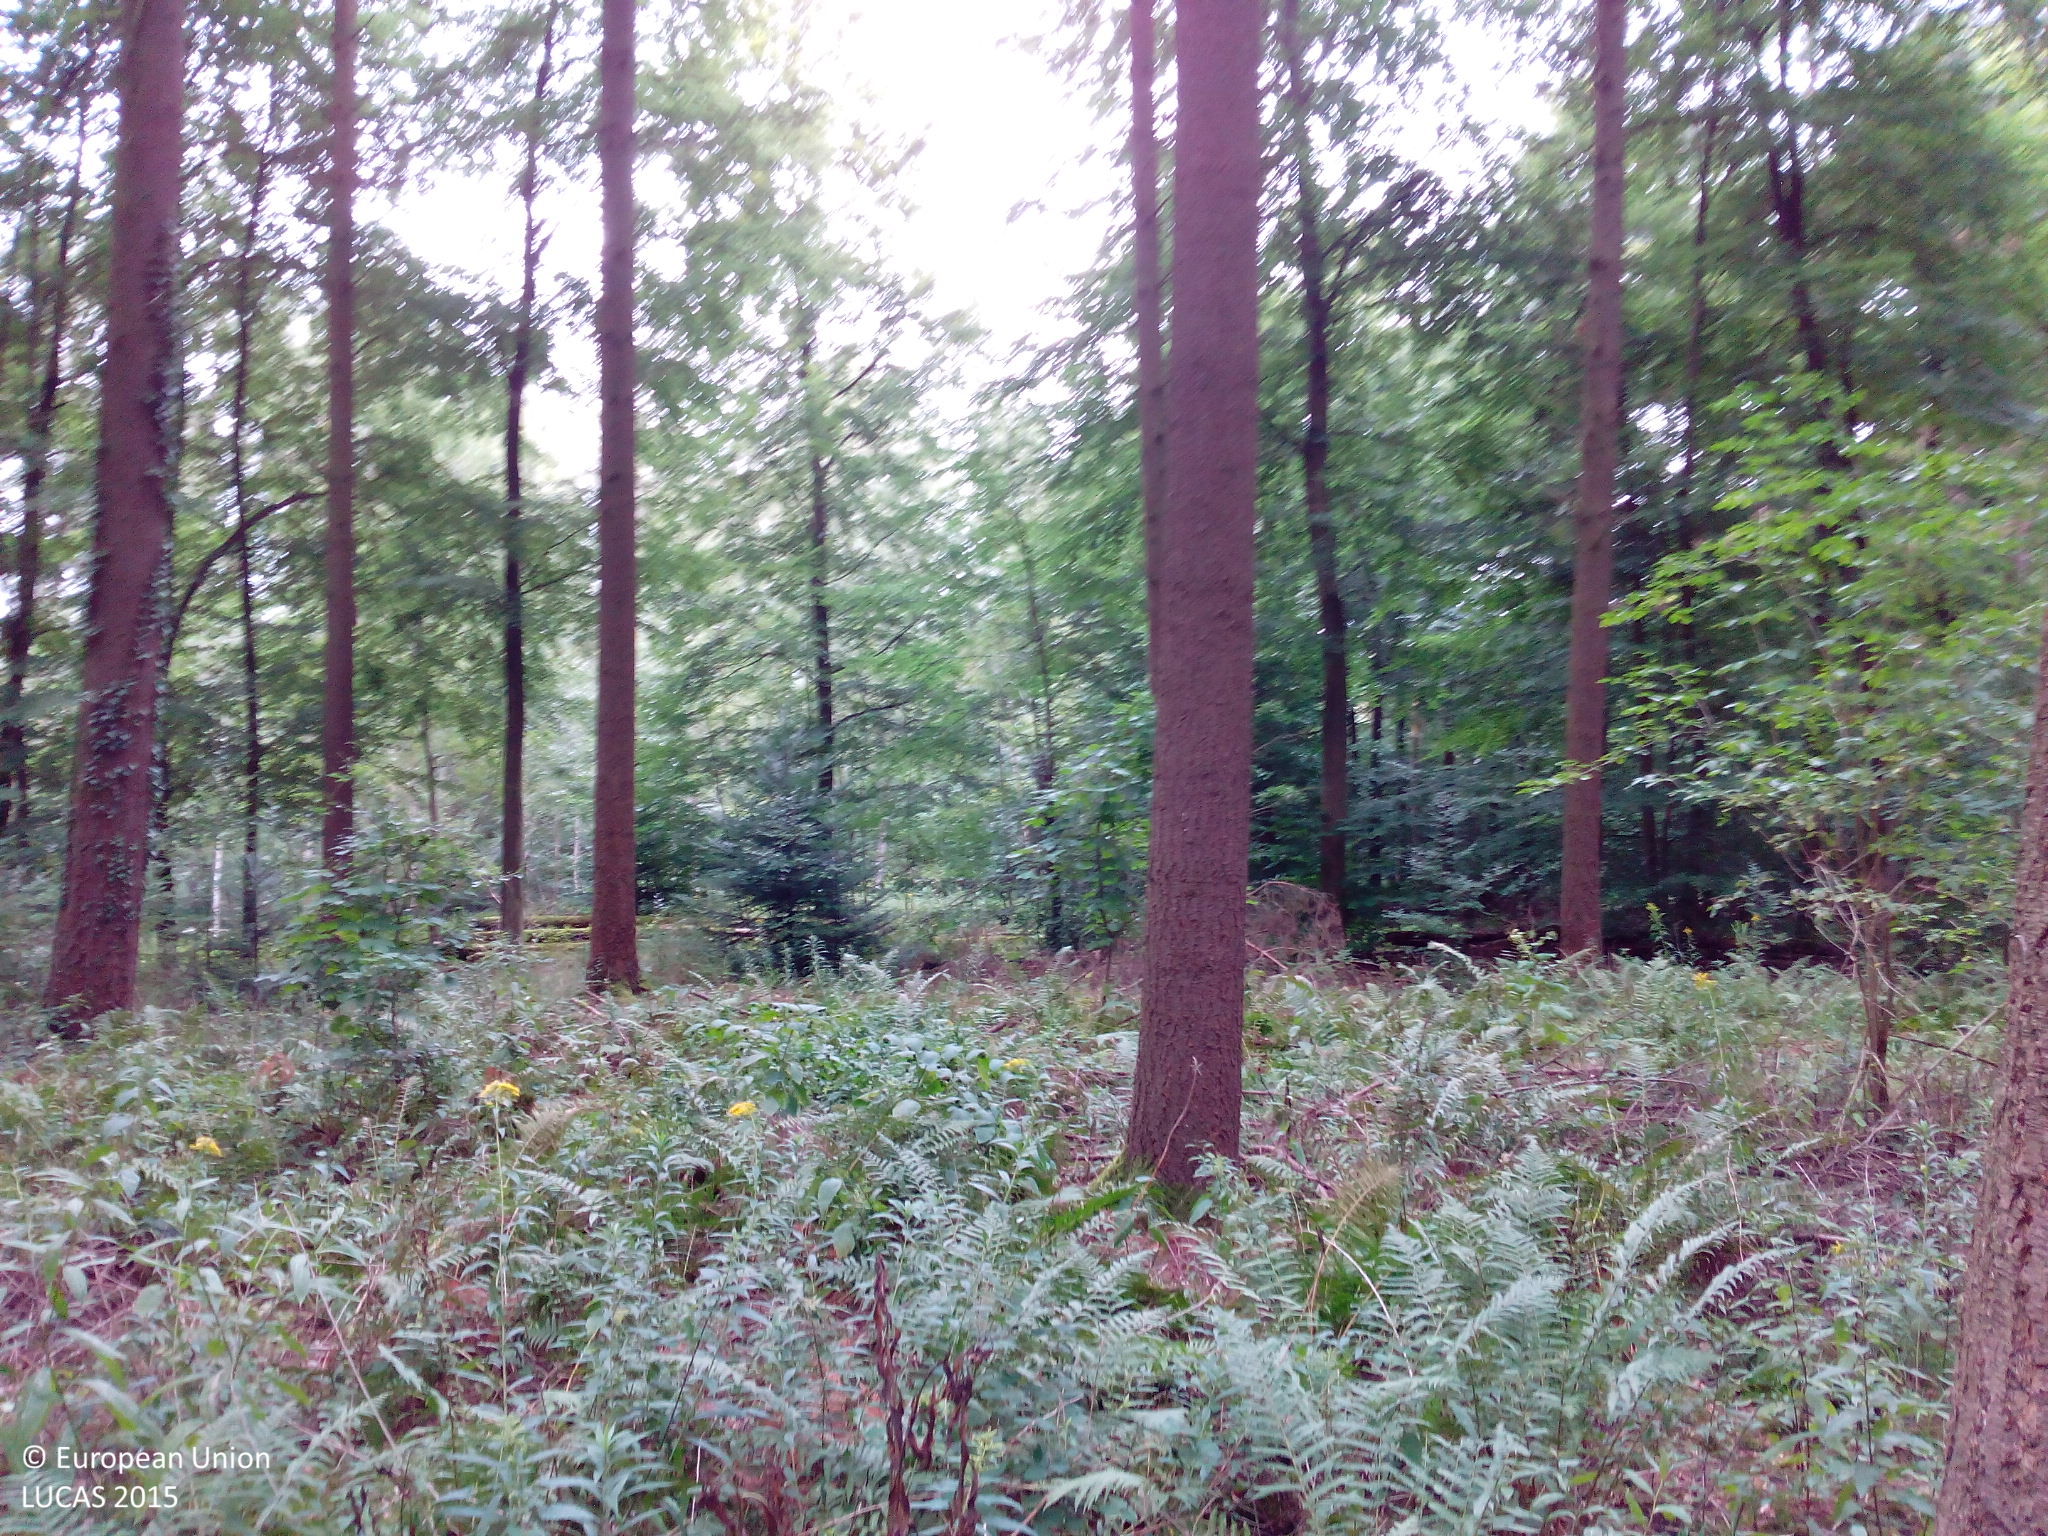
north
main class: Woodland
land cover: Spruce dominated coniferous woodland
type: hemiboreal forest and nemoral coniferous forest and mixed broadleaved-coniferous forest
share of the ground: 50 - 75 %
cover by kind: coniferous forest trees 60 %, herbaceous plants 25 %, unconsolidated bare surface 10 %, broadleaved forest trees 5 %
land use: Forestry
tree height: > 5 m
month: August
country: DE
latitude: 49.1152
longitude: 8.6715
